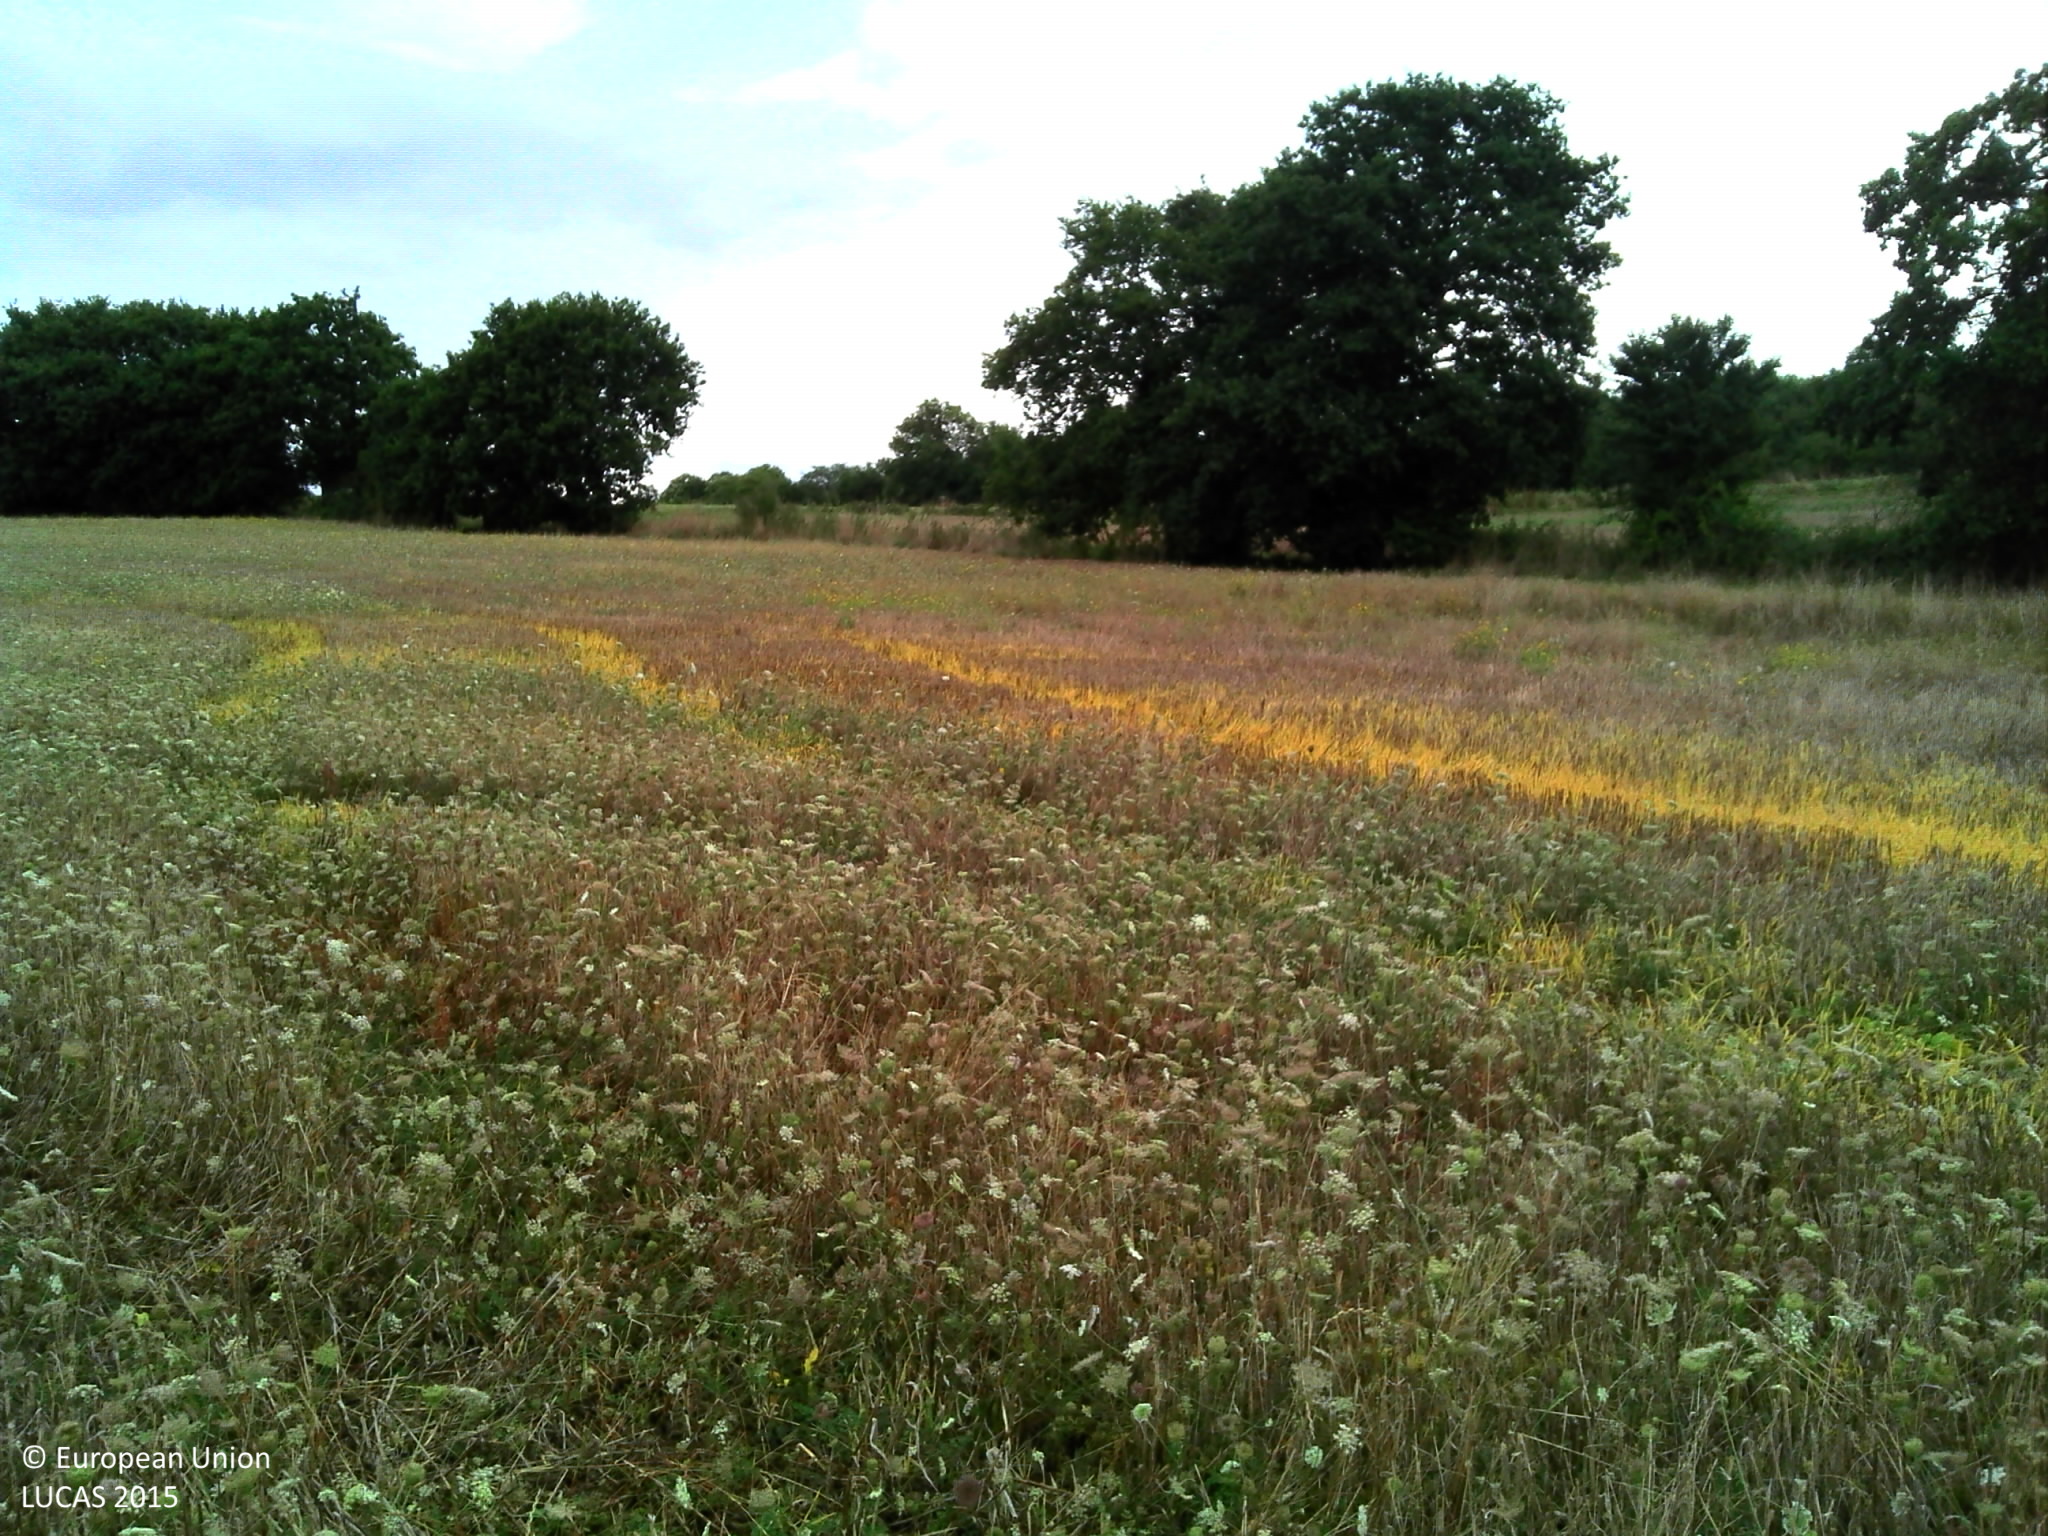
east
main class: Grassland
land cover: Spontaneously vegetated surfaces
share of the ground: > 75 %
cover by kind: herbaceous plants 100 %
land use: Fallow land
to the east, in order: Spontaneously vegetated surfaces; Lines of trees; Common wheat; Grass margins; Tracks; Grass margins; Common wheat; Lines of trees; Fences; Spontaneously vegetated surfaces; Lines of trees; Fences; Grassland with sparse tree/shrub cover; Fences; Lines of trees; Grassland without tree/shrub cover
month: August
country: FR
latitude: 48.5872
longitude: -2.1356
